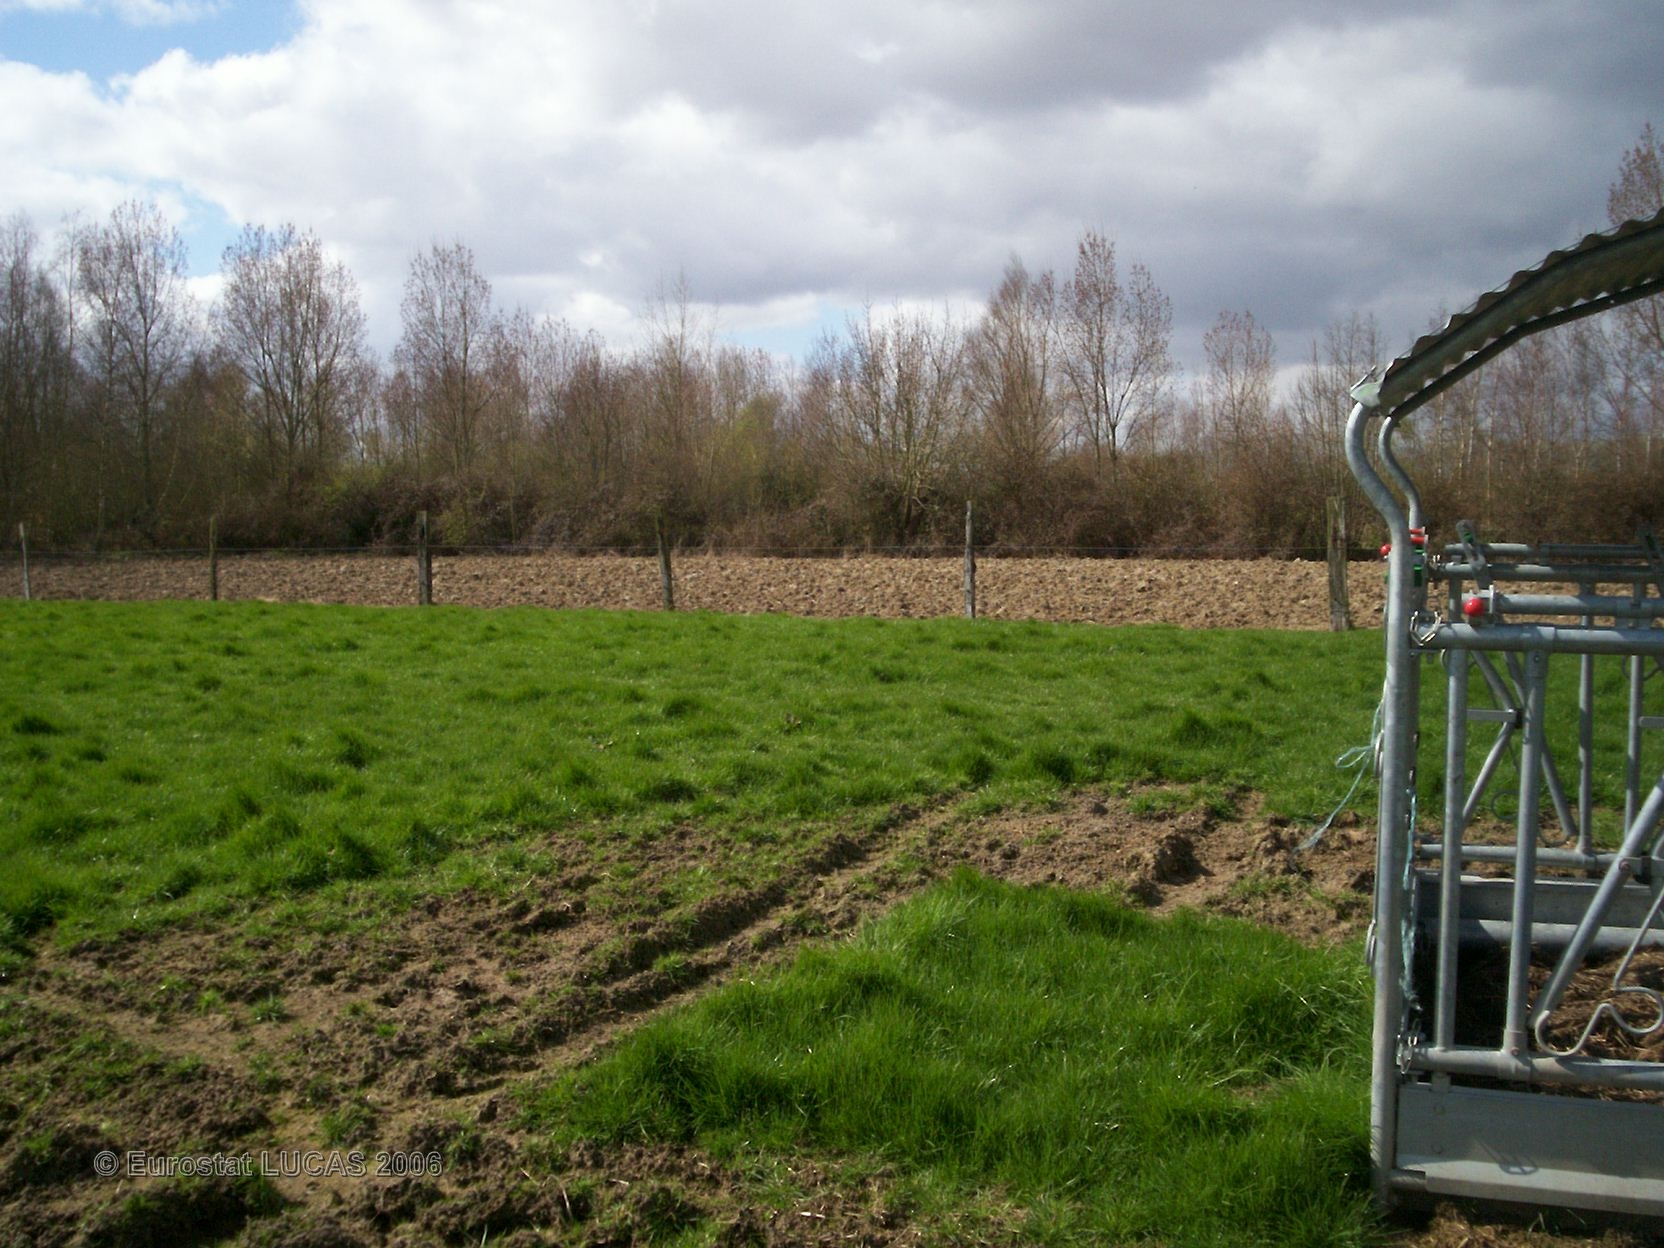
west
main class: Grassland
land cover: Grassland without tree/shrub cover
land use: Agriculture (excluding fallow land and kitchen gardens)
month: April
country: FR
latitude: 50.5937
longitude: 2.5998
